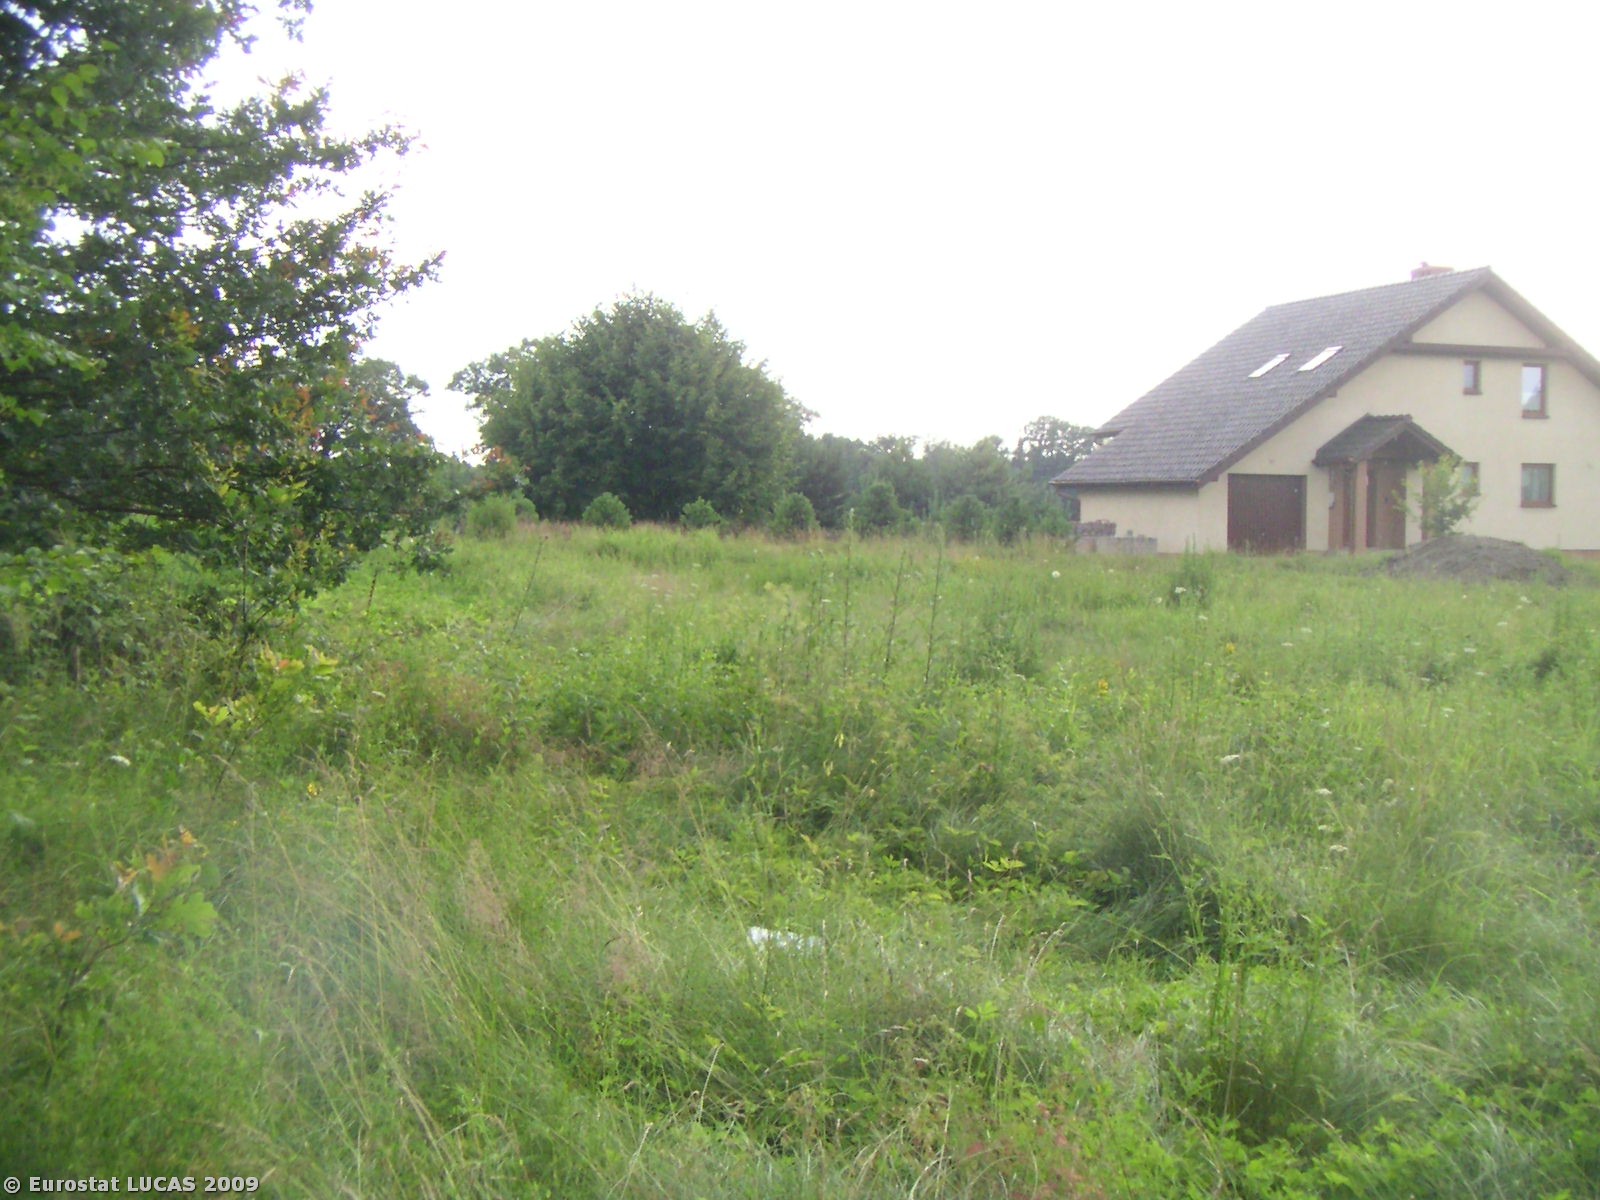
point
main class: Grassland
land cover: Grassland with sparse tree/shrub cover
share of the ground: > 75 %
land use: Agriculture (excluding fallow land and kitchen gardens)
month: July
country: PL
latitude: 50.0821
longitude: 18.7553
